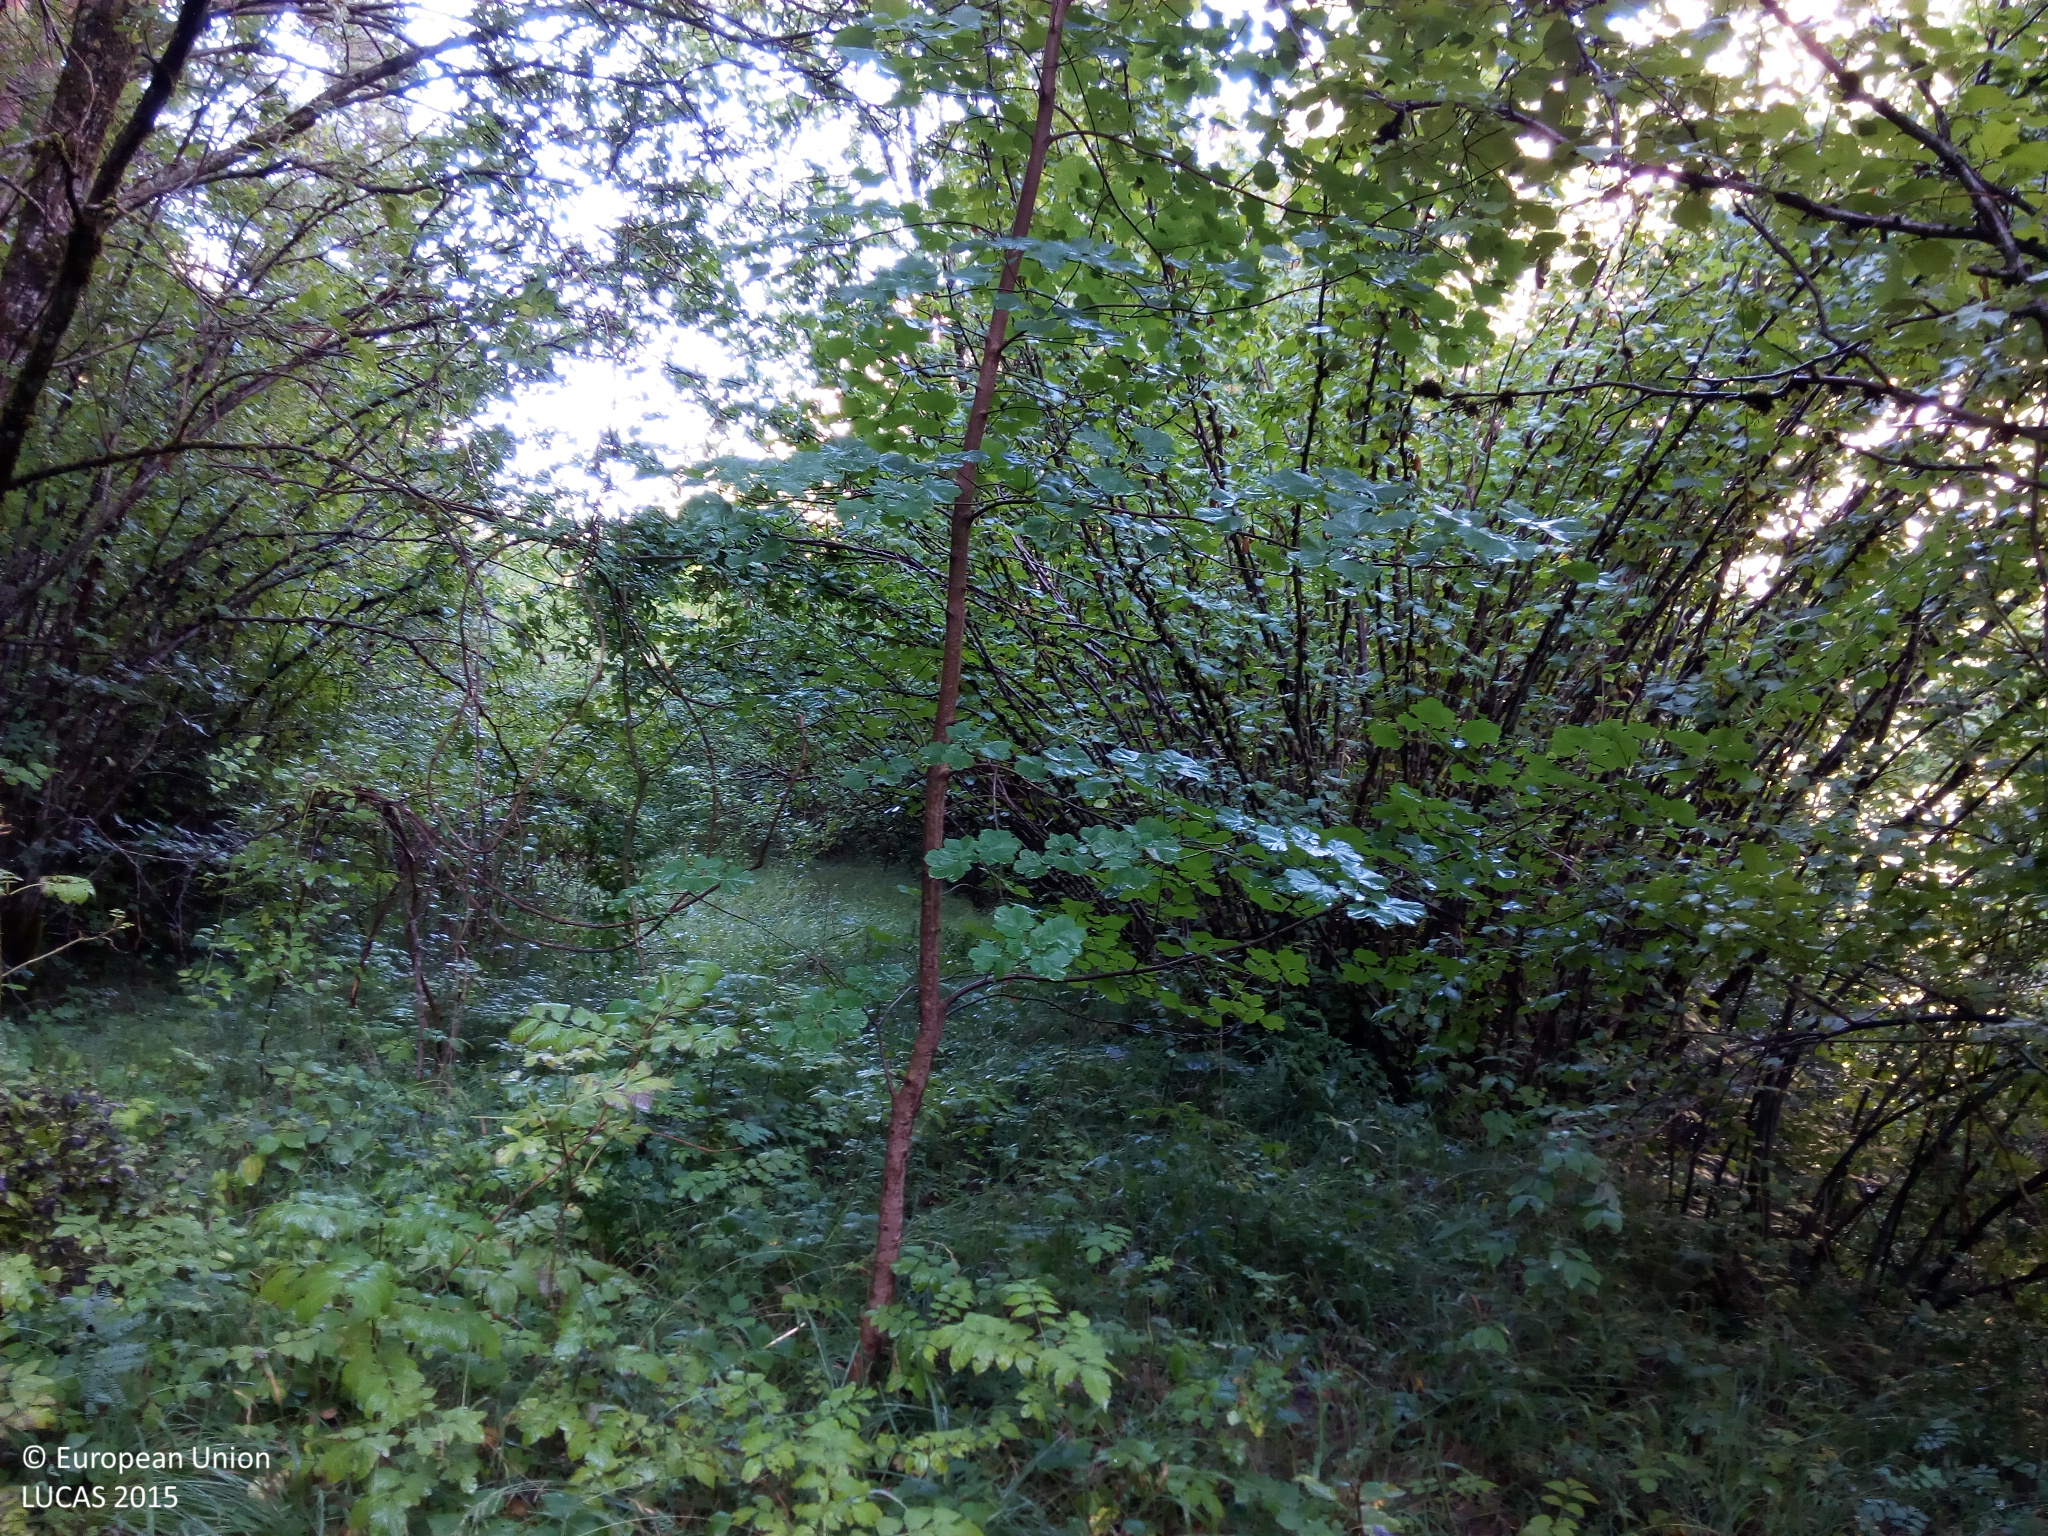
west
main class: Woodland
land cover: Pine dominated coniferous woodland
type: alpine coniferous forest
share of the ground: > 75 %
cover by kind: coniferous forest trees 100 %
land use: Semi-natural and natural areas not in use
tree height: > 5 m
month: September
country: ES
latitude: 42.5709
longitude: 0.3182
